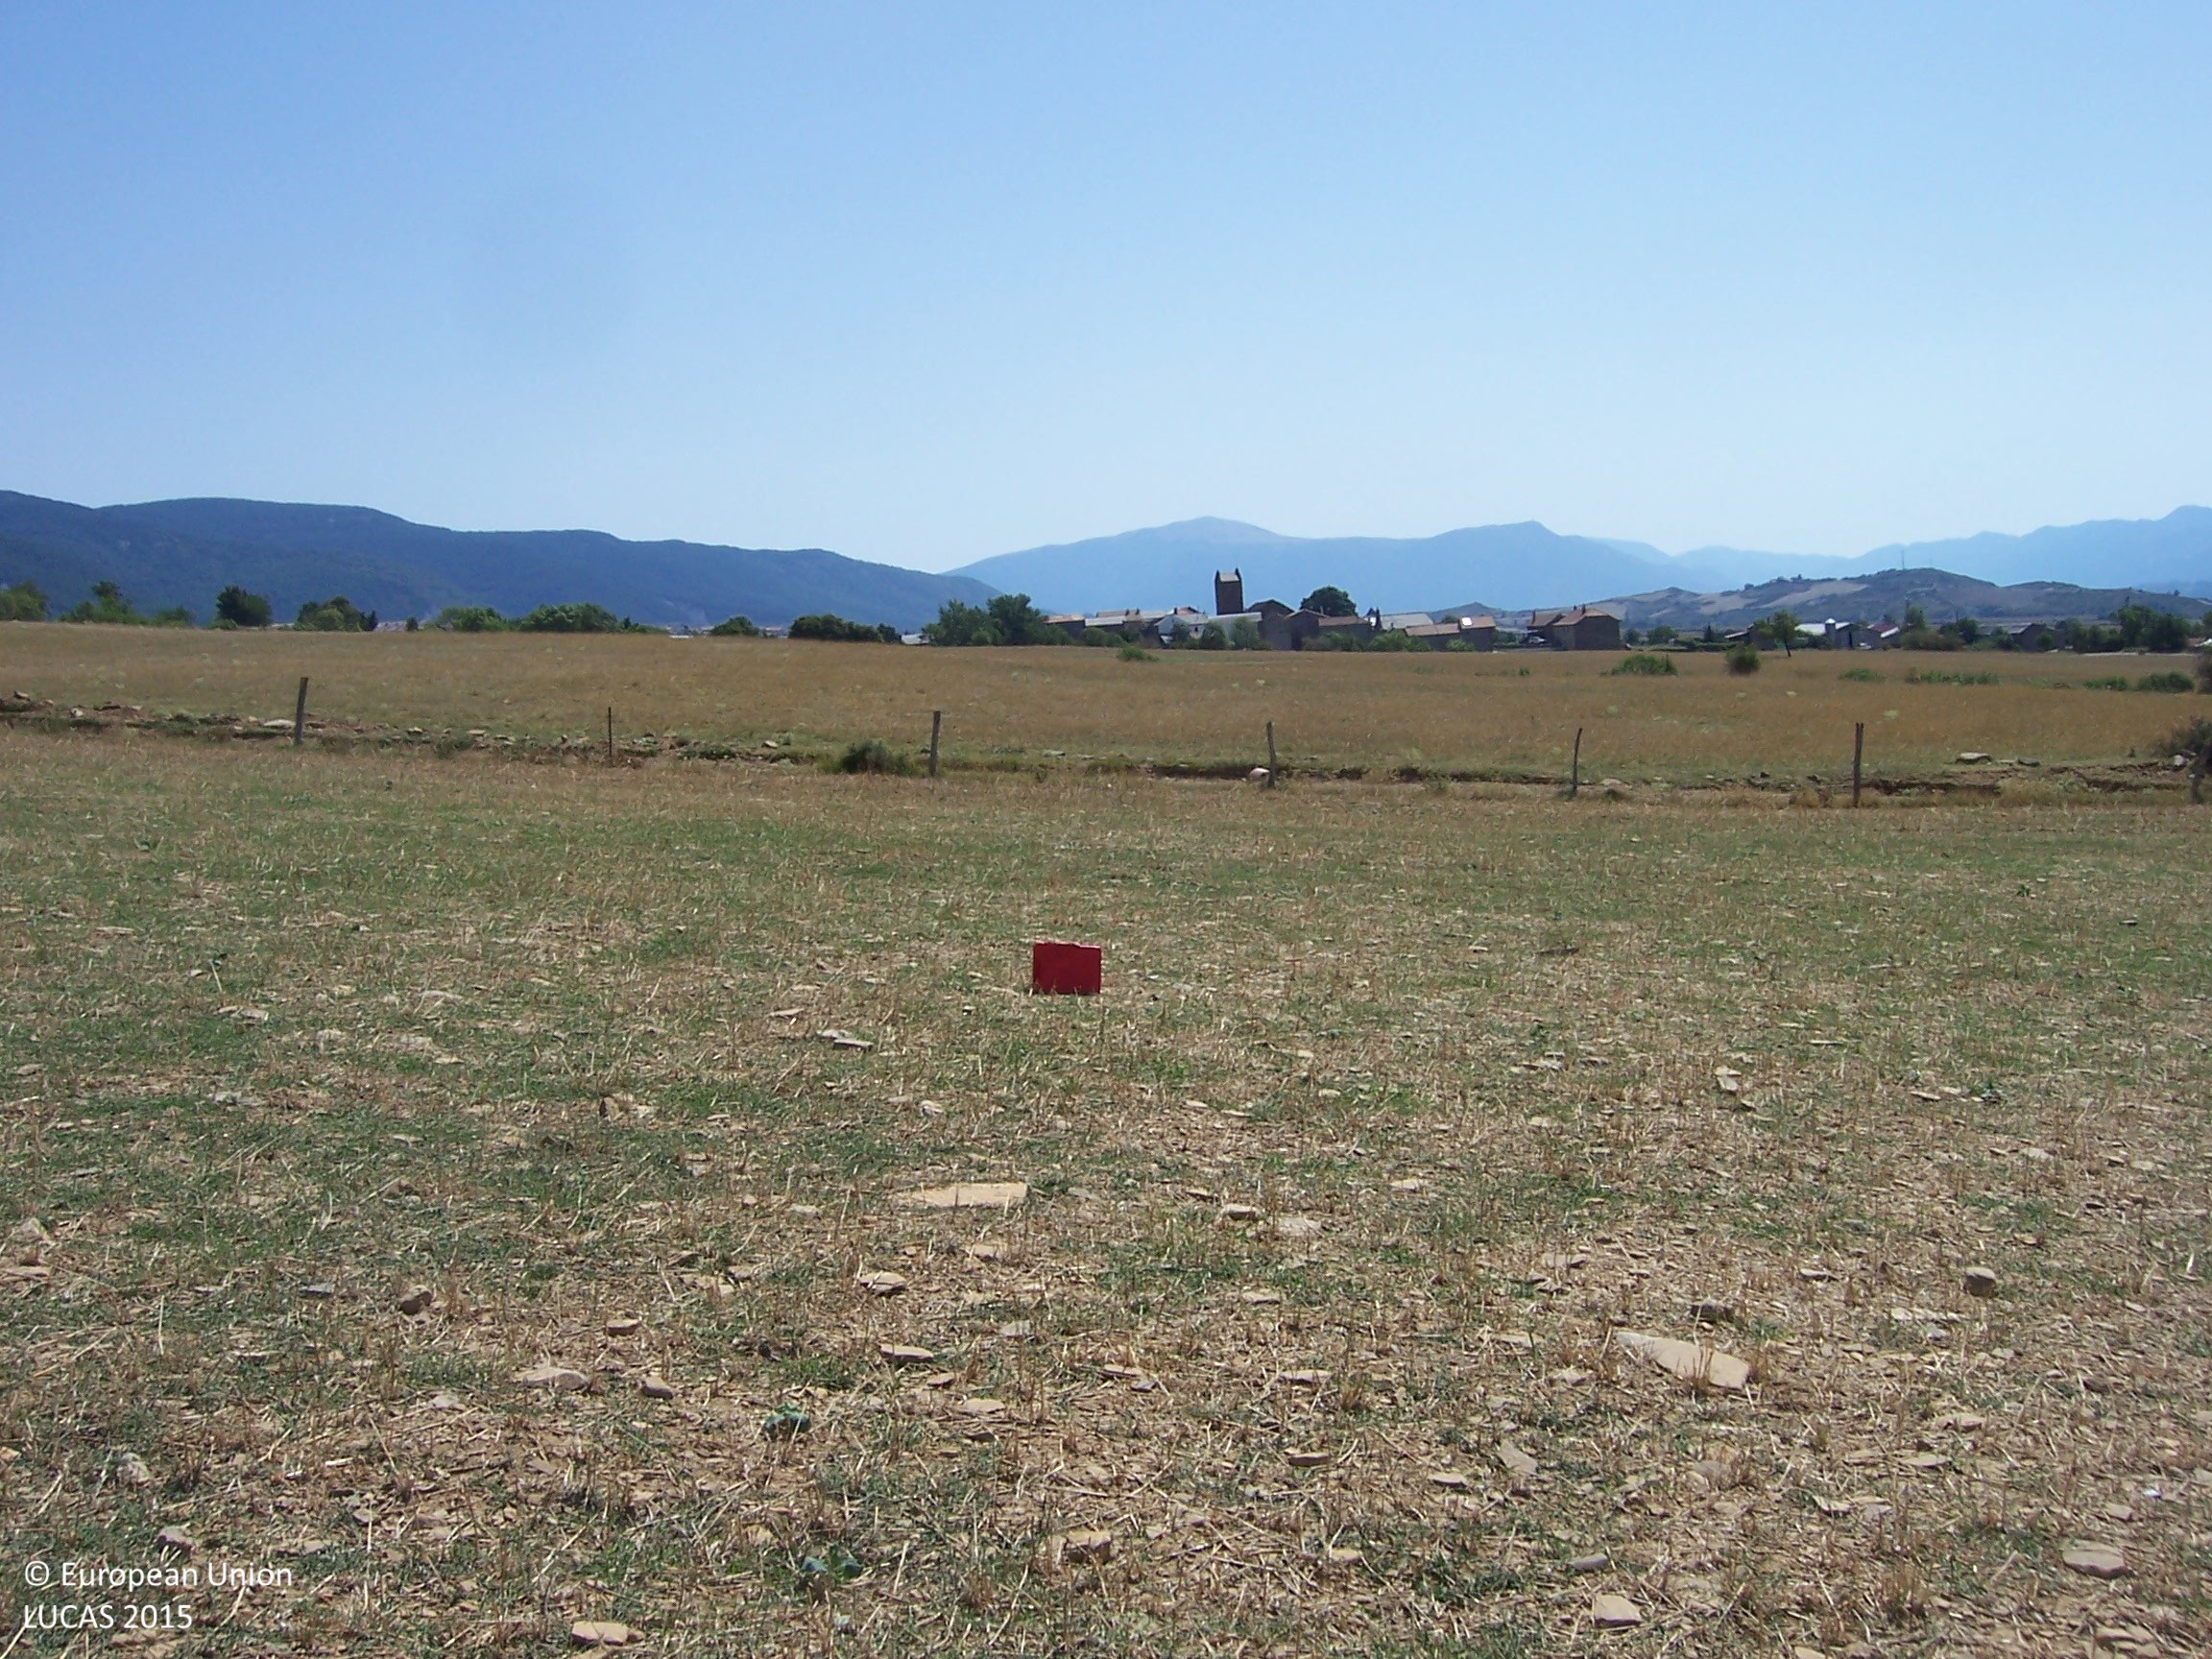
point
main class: Grassland
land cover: Grassland without tree/shrub cover
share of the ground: 50 - 75 %
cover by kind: herbaceous plants 60 %, unconsolidated bare surface 40 %
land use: Agriculture (excluding fallow land and kitchen gardens)
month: August
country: ES
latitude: 42.5806
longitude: -0.4930
